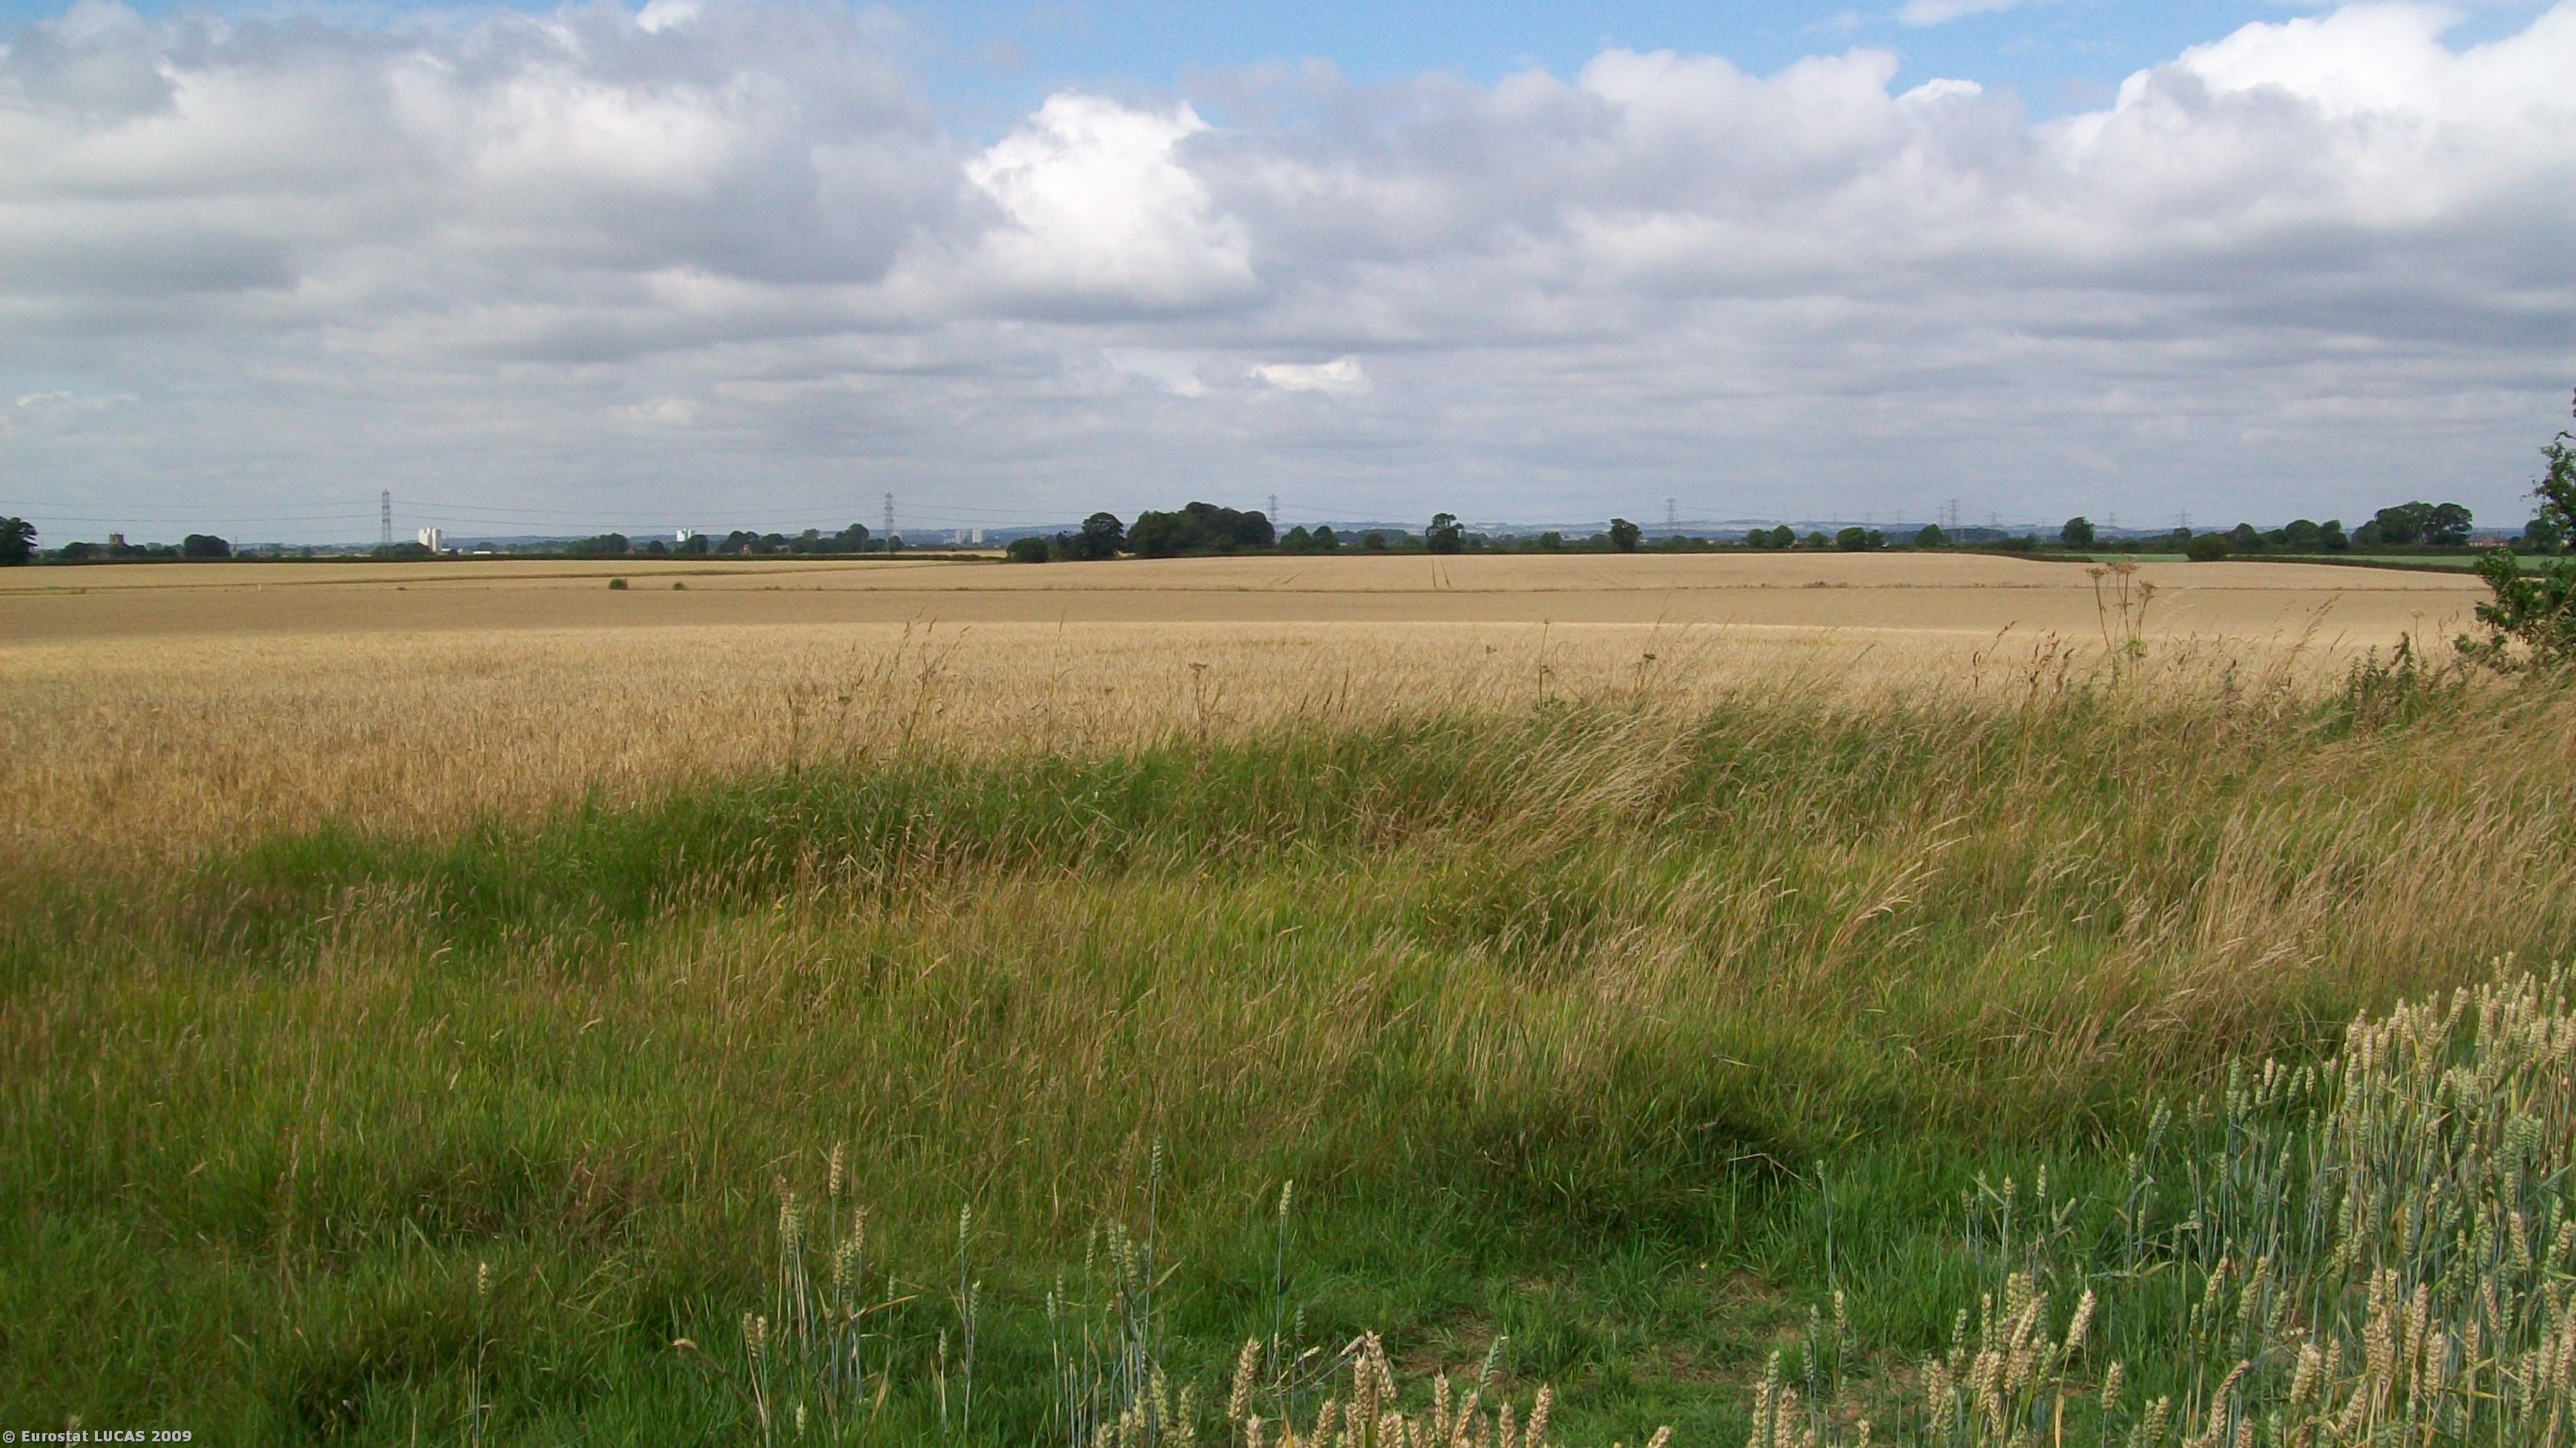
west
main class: Cropland
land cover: Common wheat
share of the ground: > 75 %
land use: Agriculture (excluding fallow land and kitchen gardens)
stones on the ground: < 10 %
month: July
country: GB
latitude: 53.8173
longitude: -0.2564
